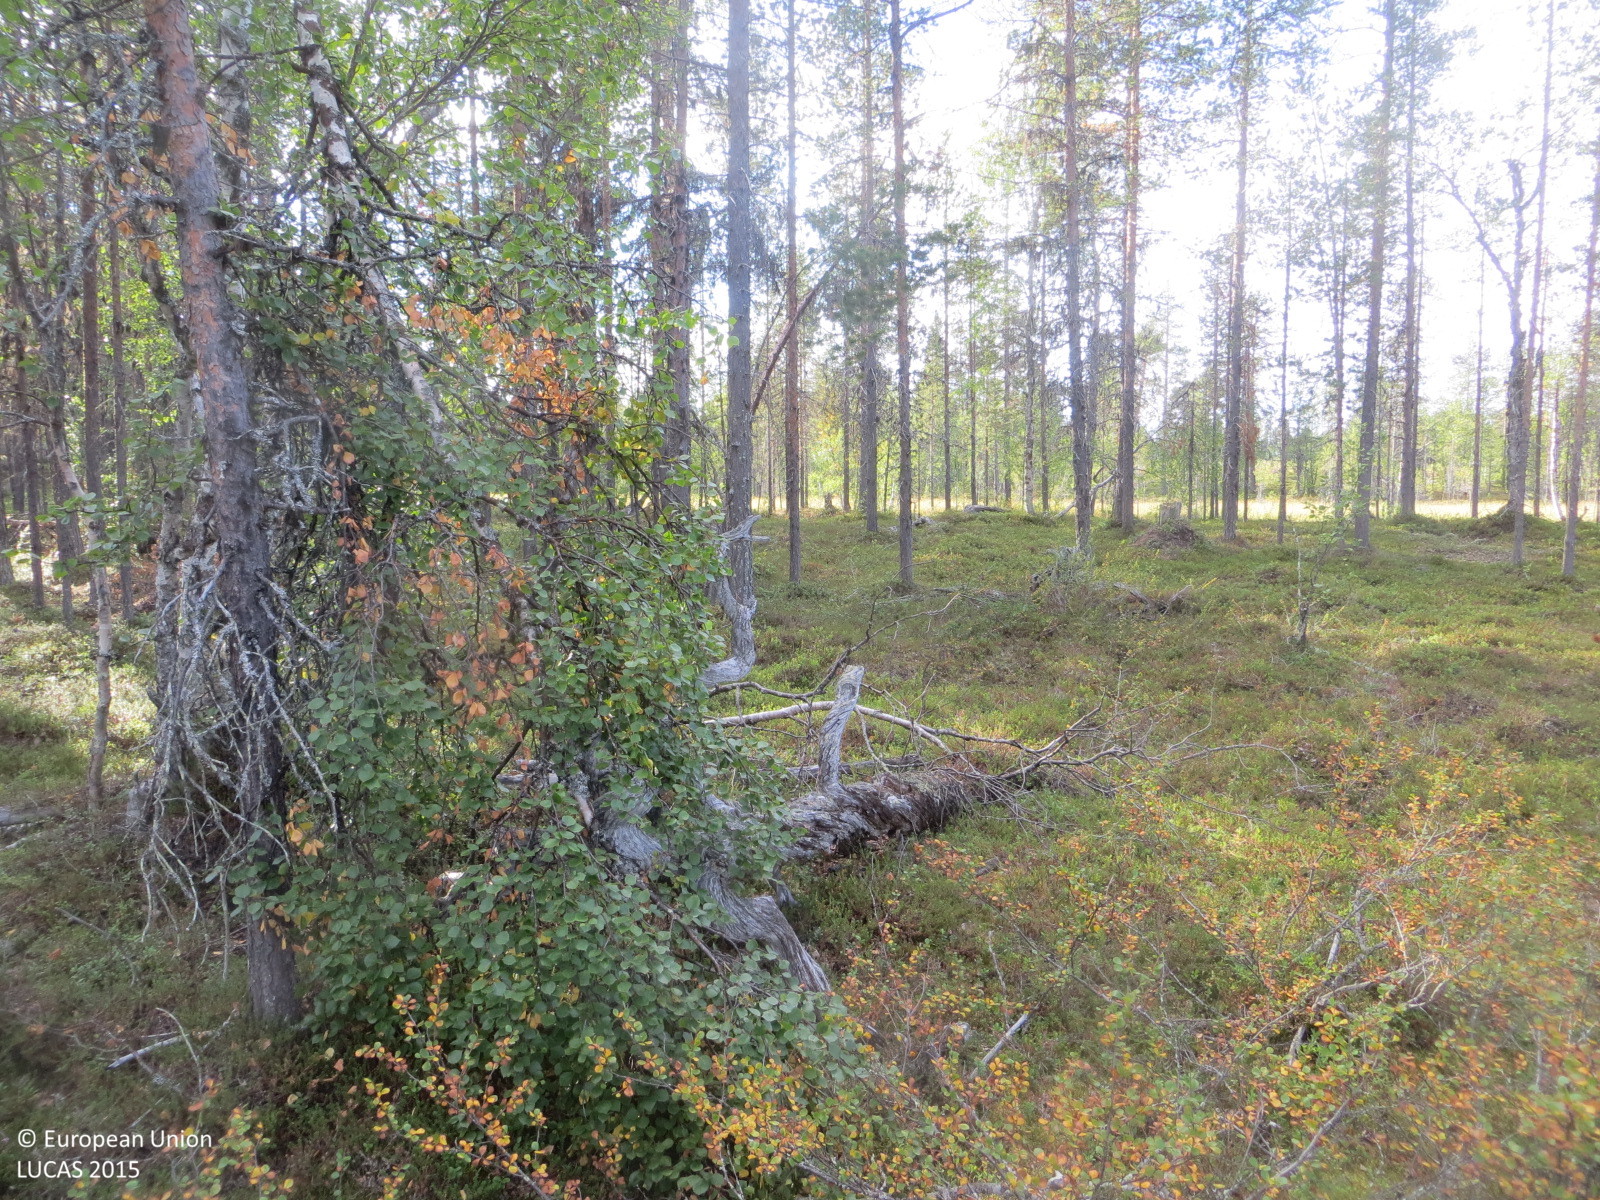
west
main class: Woodland
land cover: Pine dominated coniferous woodland
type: boreal forest
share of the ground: 50 - 75 %
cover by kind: shrubs 50 %, coniferous forest trees 45 %, broadleaved forest trees 5 %
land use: Forestry
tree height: > 5 m
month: August
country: FI
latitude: 68.2123
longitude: 25.6610
